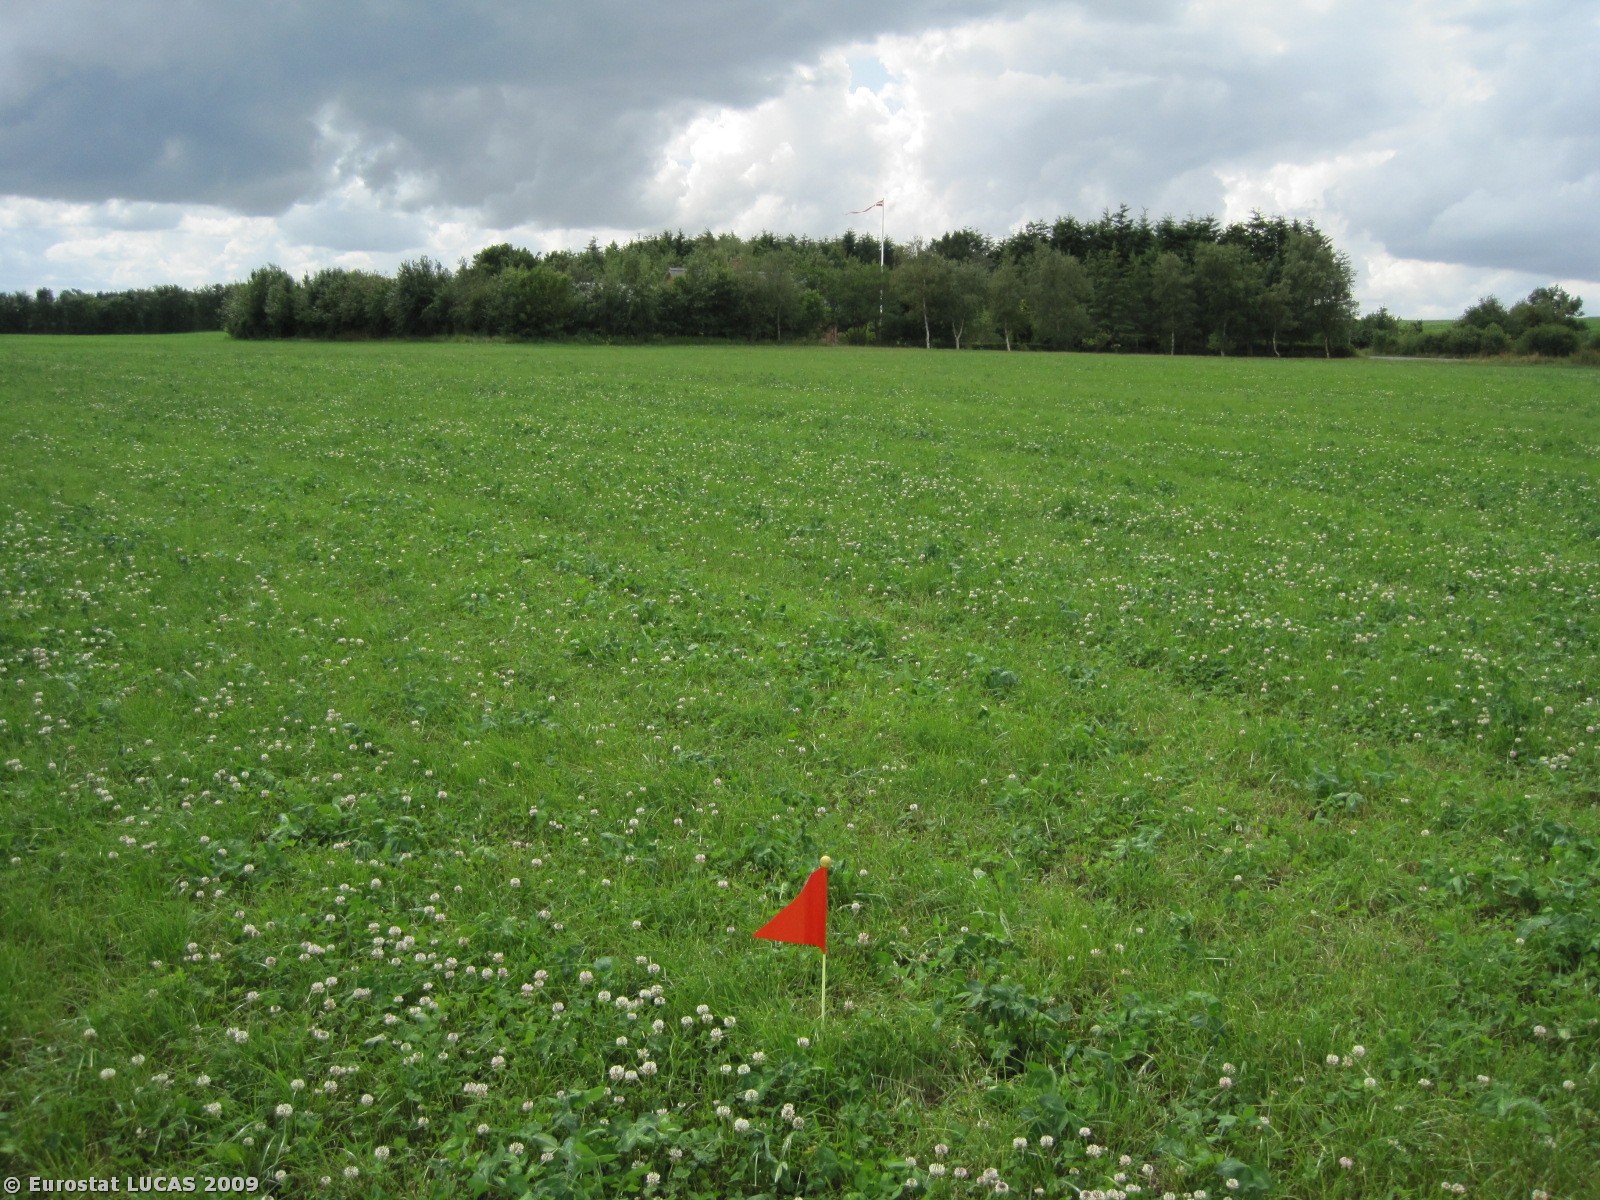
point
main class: Cropland
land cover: Temporary grasslands
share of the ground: > 75 %
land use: Agriculture (excluding fallow land and kitchen gardens)
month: July
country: DK
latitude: 56.3992
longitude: 8.9482
